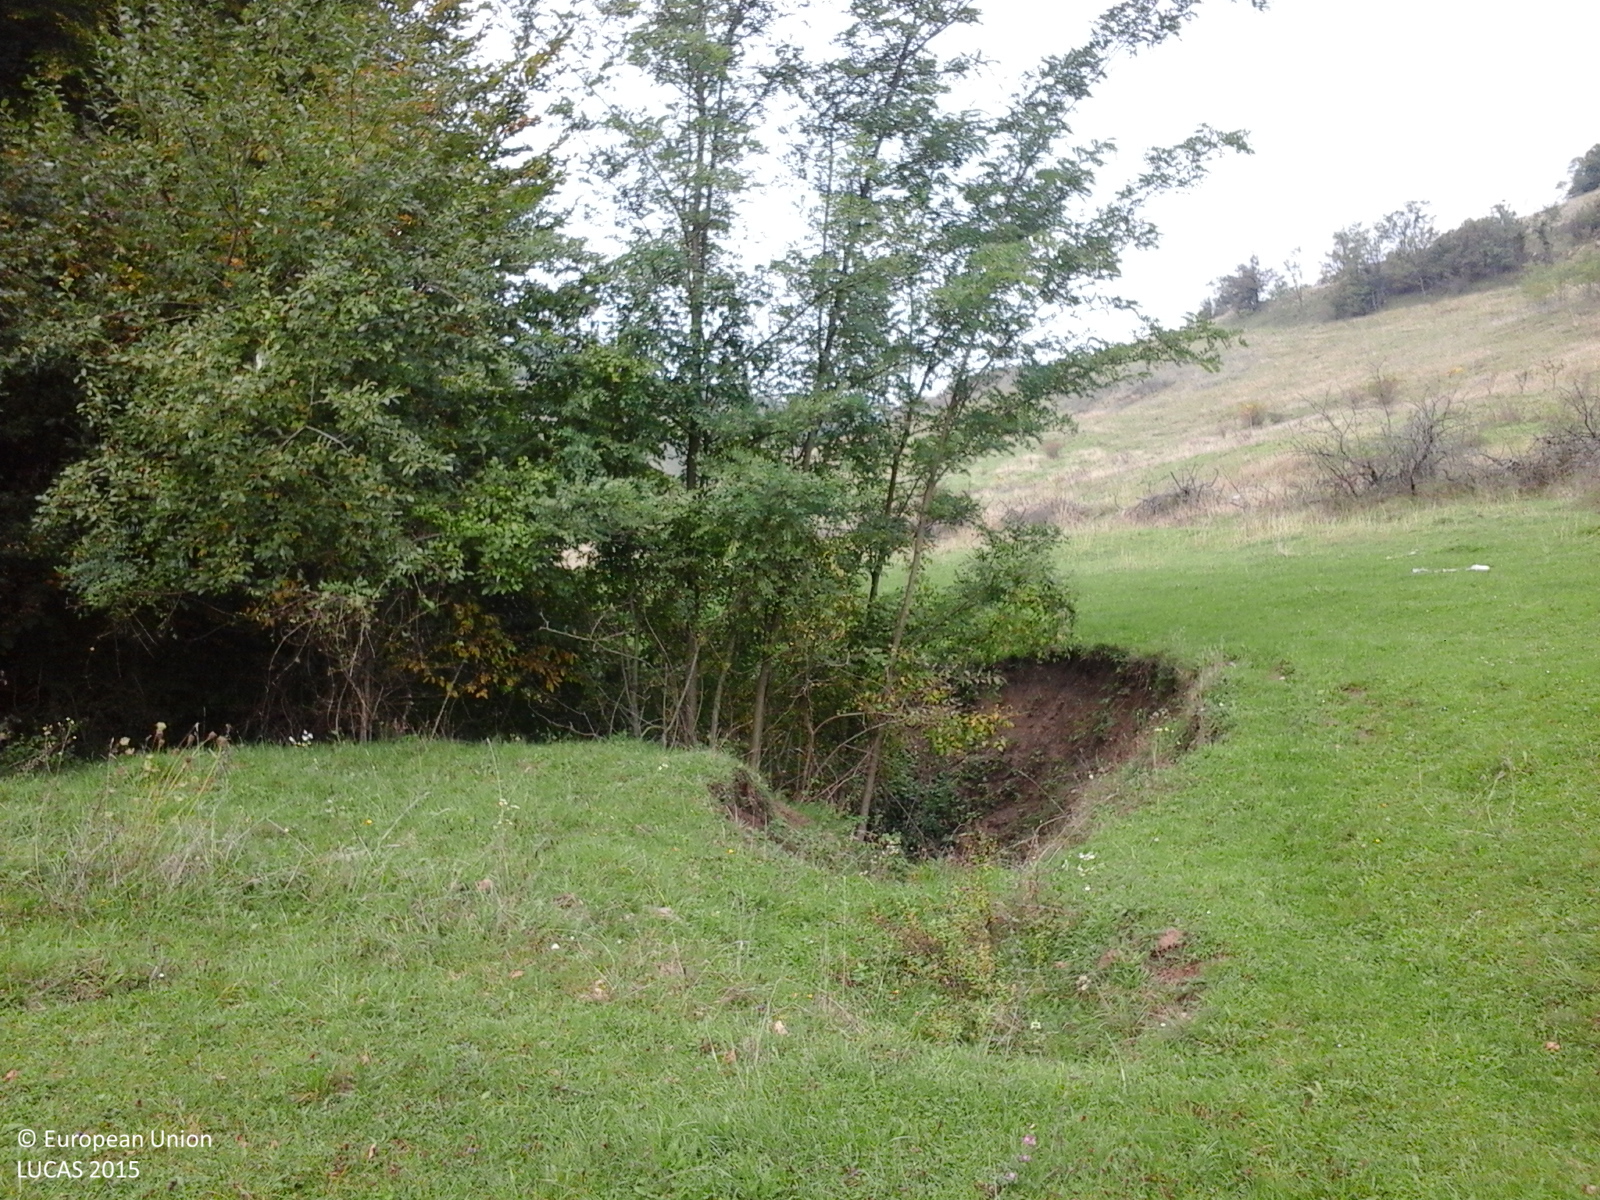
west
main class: Grassland
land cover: Grassland without tree/shrub cover
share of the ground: > 75 %
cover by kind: herbaceous plants 100 %
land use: Agriculture (excluding fallow land and kitchen gardens)
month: October
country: RO
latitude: 46.3129
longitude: 24.8578
